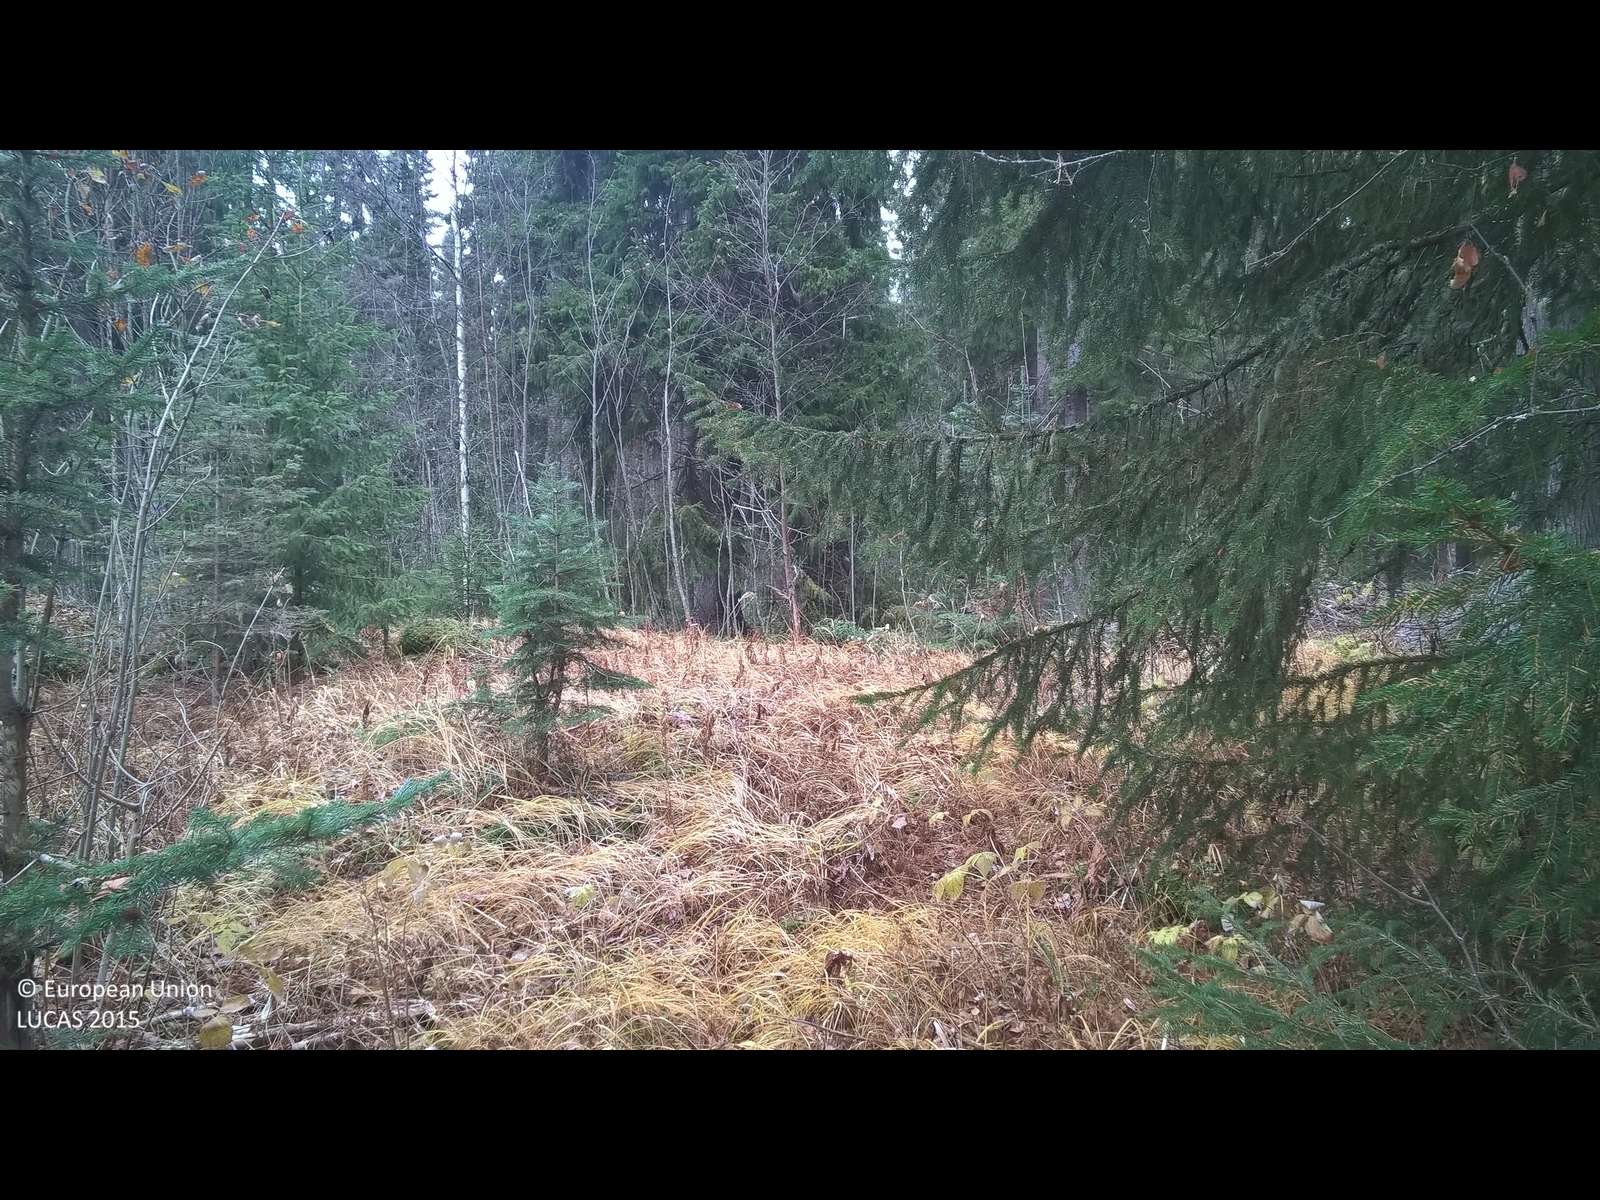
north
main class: Woodland
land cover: Spruce dominated mixed woodland
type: boreal forest
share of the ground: 25 - 50 %
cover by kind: lichens and mosses 40 %, coniferous forest trees 30 %, broadleaved forest trees 15 %, herbaceous plants 10 %, shrubs 5 %
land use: Forestry
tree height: > 5 m
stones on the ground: < 10 %
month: October
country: SE
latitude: 62.9576
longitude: 15.1634
